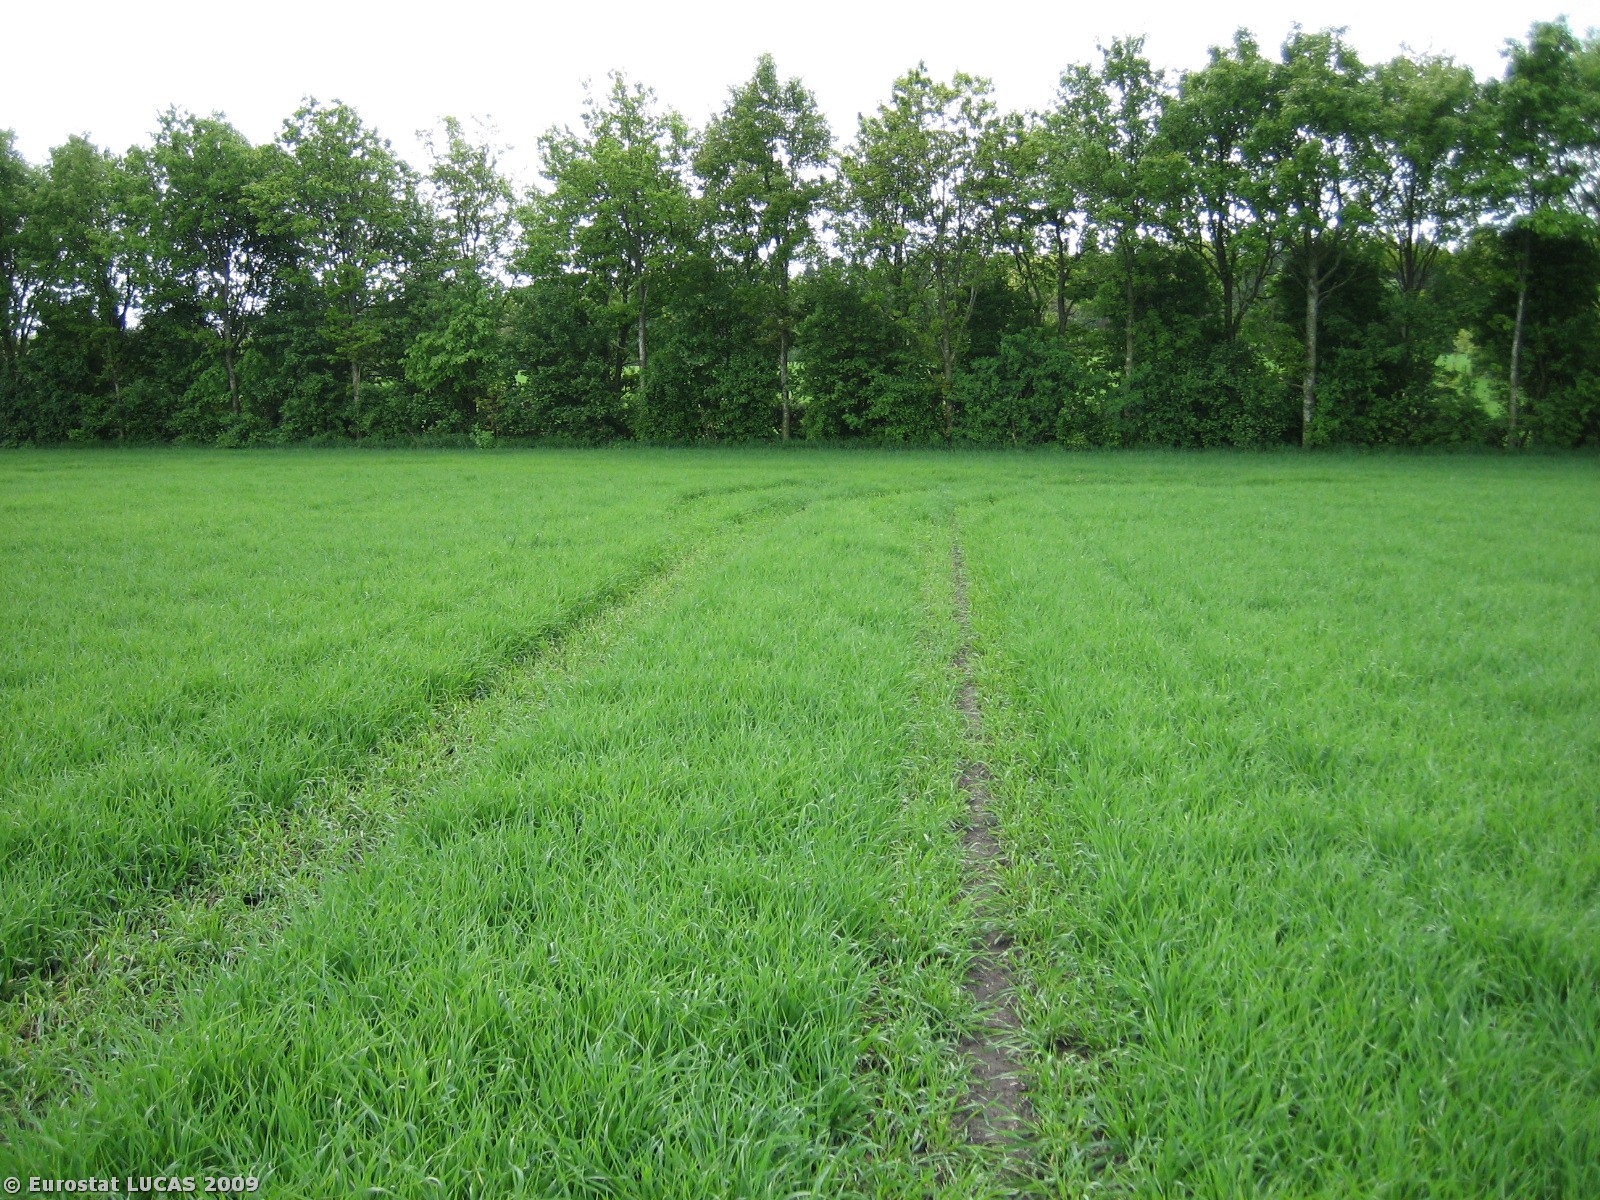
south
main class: Cropland
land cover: Barley
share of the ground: > 75 %
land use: Agriculture (excluding fallow land and kitchen gardens)
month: May
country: DK
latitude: 56.1467
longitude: 8.8585
